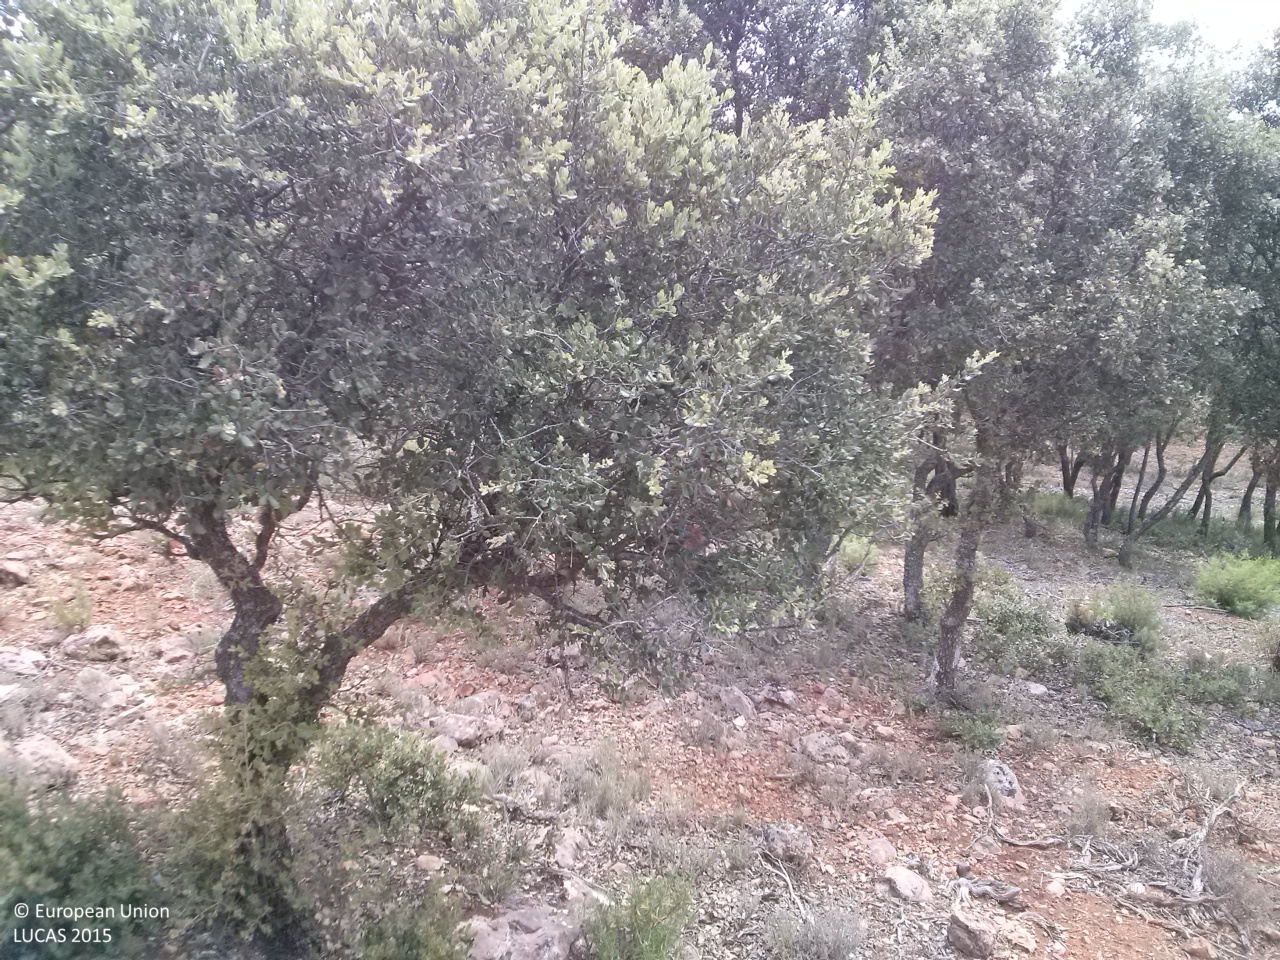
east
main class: Woodland
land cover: Other mixed woodland
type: broadleaved evergreen forest
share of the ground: 25 - 50 %
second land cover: Grassland without tree/shrub cover
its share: 25 - 50 %
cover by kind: herbaceous plants 30 %, broadleaved forest trees 20 %, shrubs 20 %, unconsolidated bare surface 20 %, coniferous forest trees 10 %
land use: Forestry
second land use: Agriculture (excluding fallow land and kitchen gardens)
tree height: < 5 m
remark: Clear cut
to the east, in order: Other mixed woodland; Grassland without tree/shrub cover; Other mixed woodland; Tracks; Other mixed woodland; Rivers and streams; Other mixed woodland; Broadleaved woodland
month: June
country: ES
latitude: 39.9931
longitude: -1.7825
